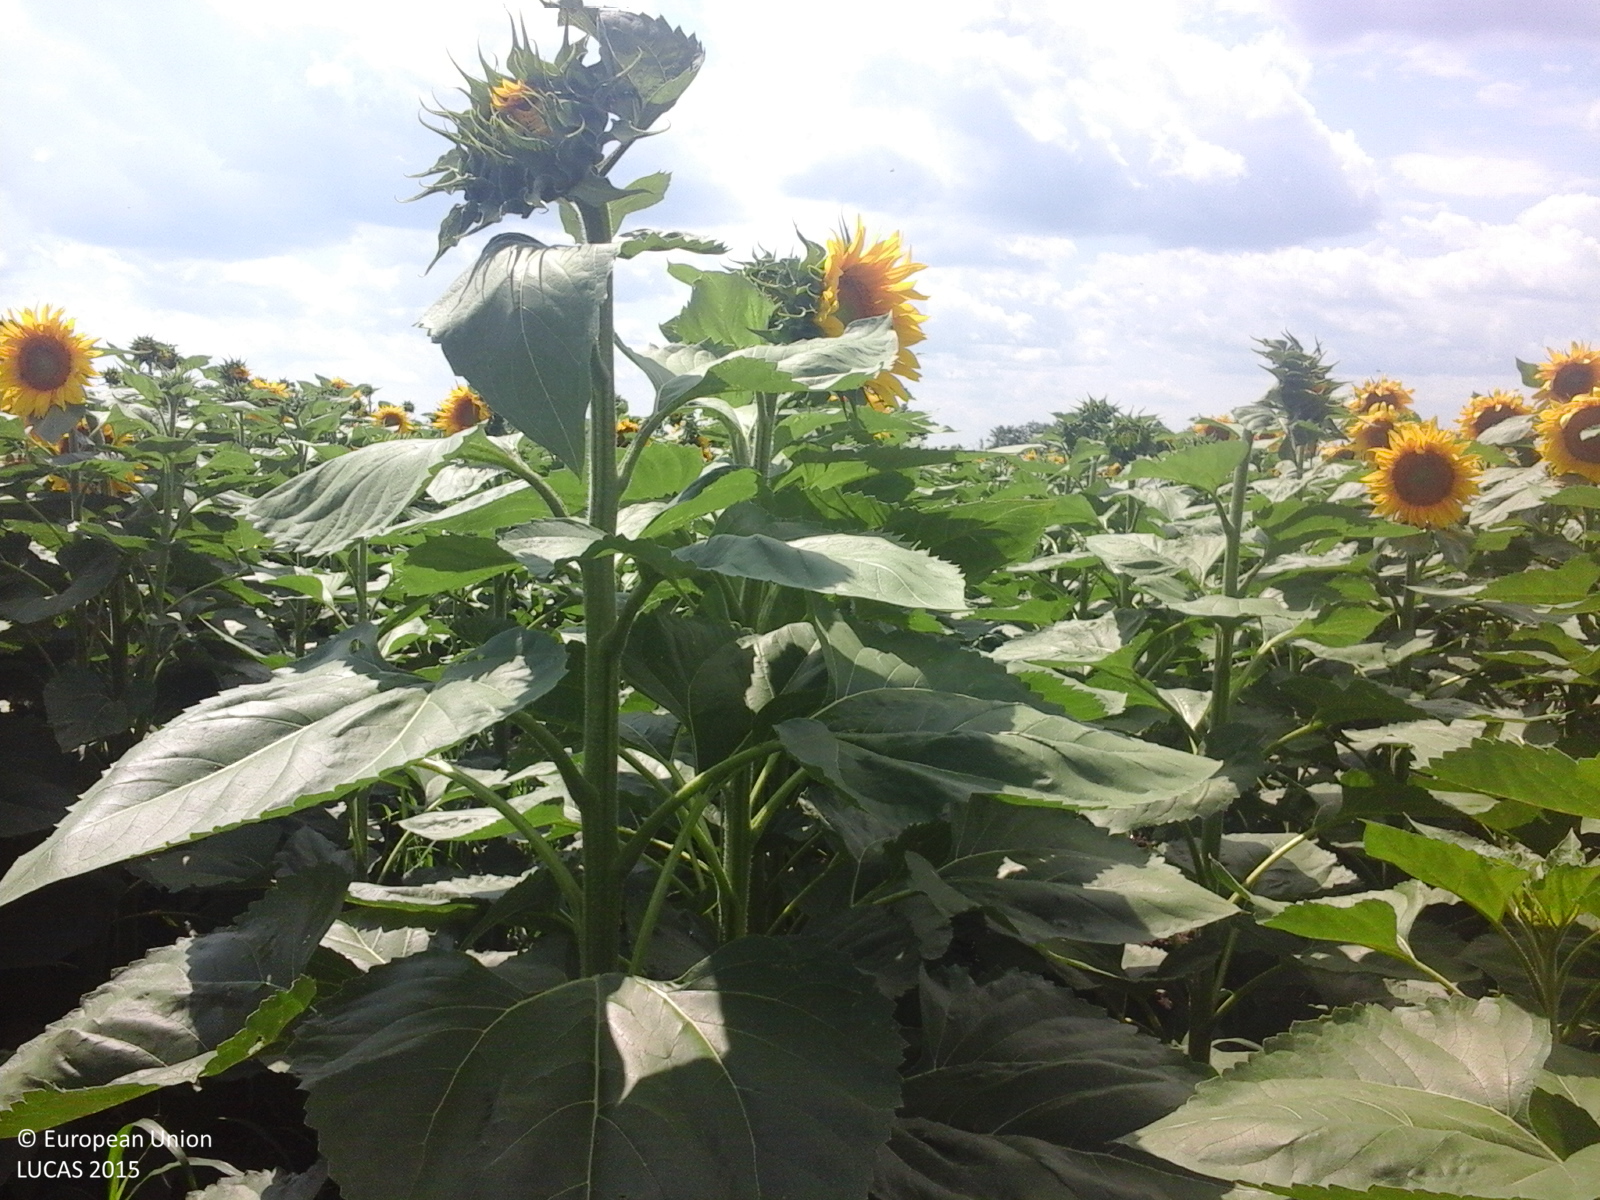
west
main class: Cropland
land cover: Sunflower
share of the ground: > 75 %
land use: Agriculture (excluding fallow land and kitchen gardens)
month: July
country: RO
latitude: 43.8549
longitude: 24.3820
